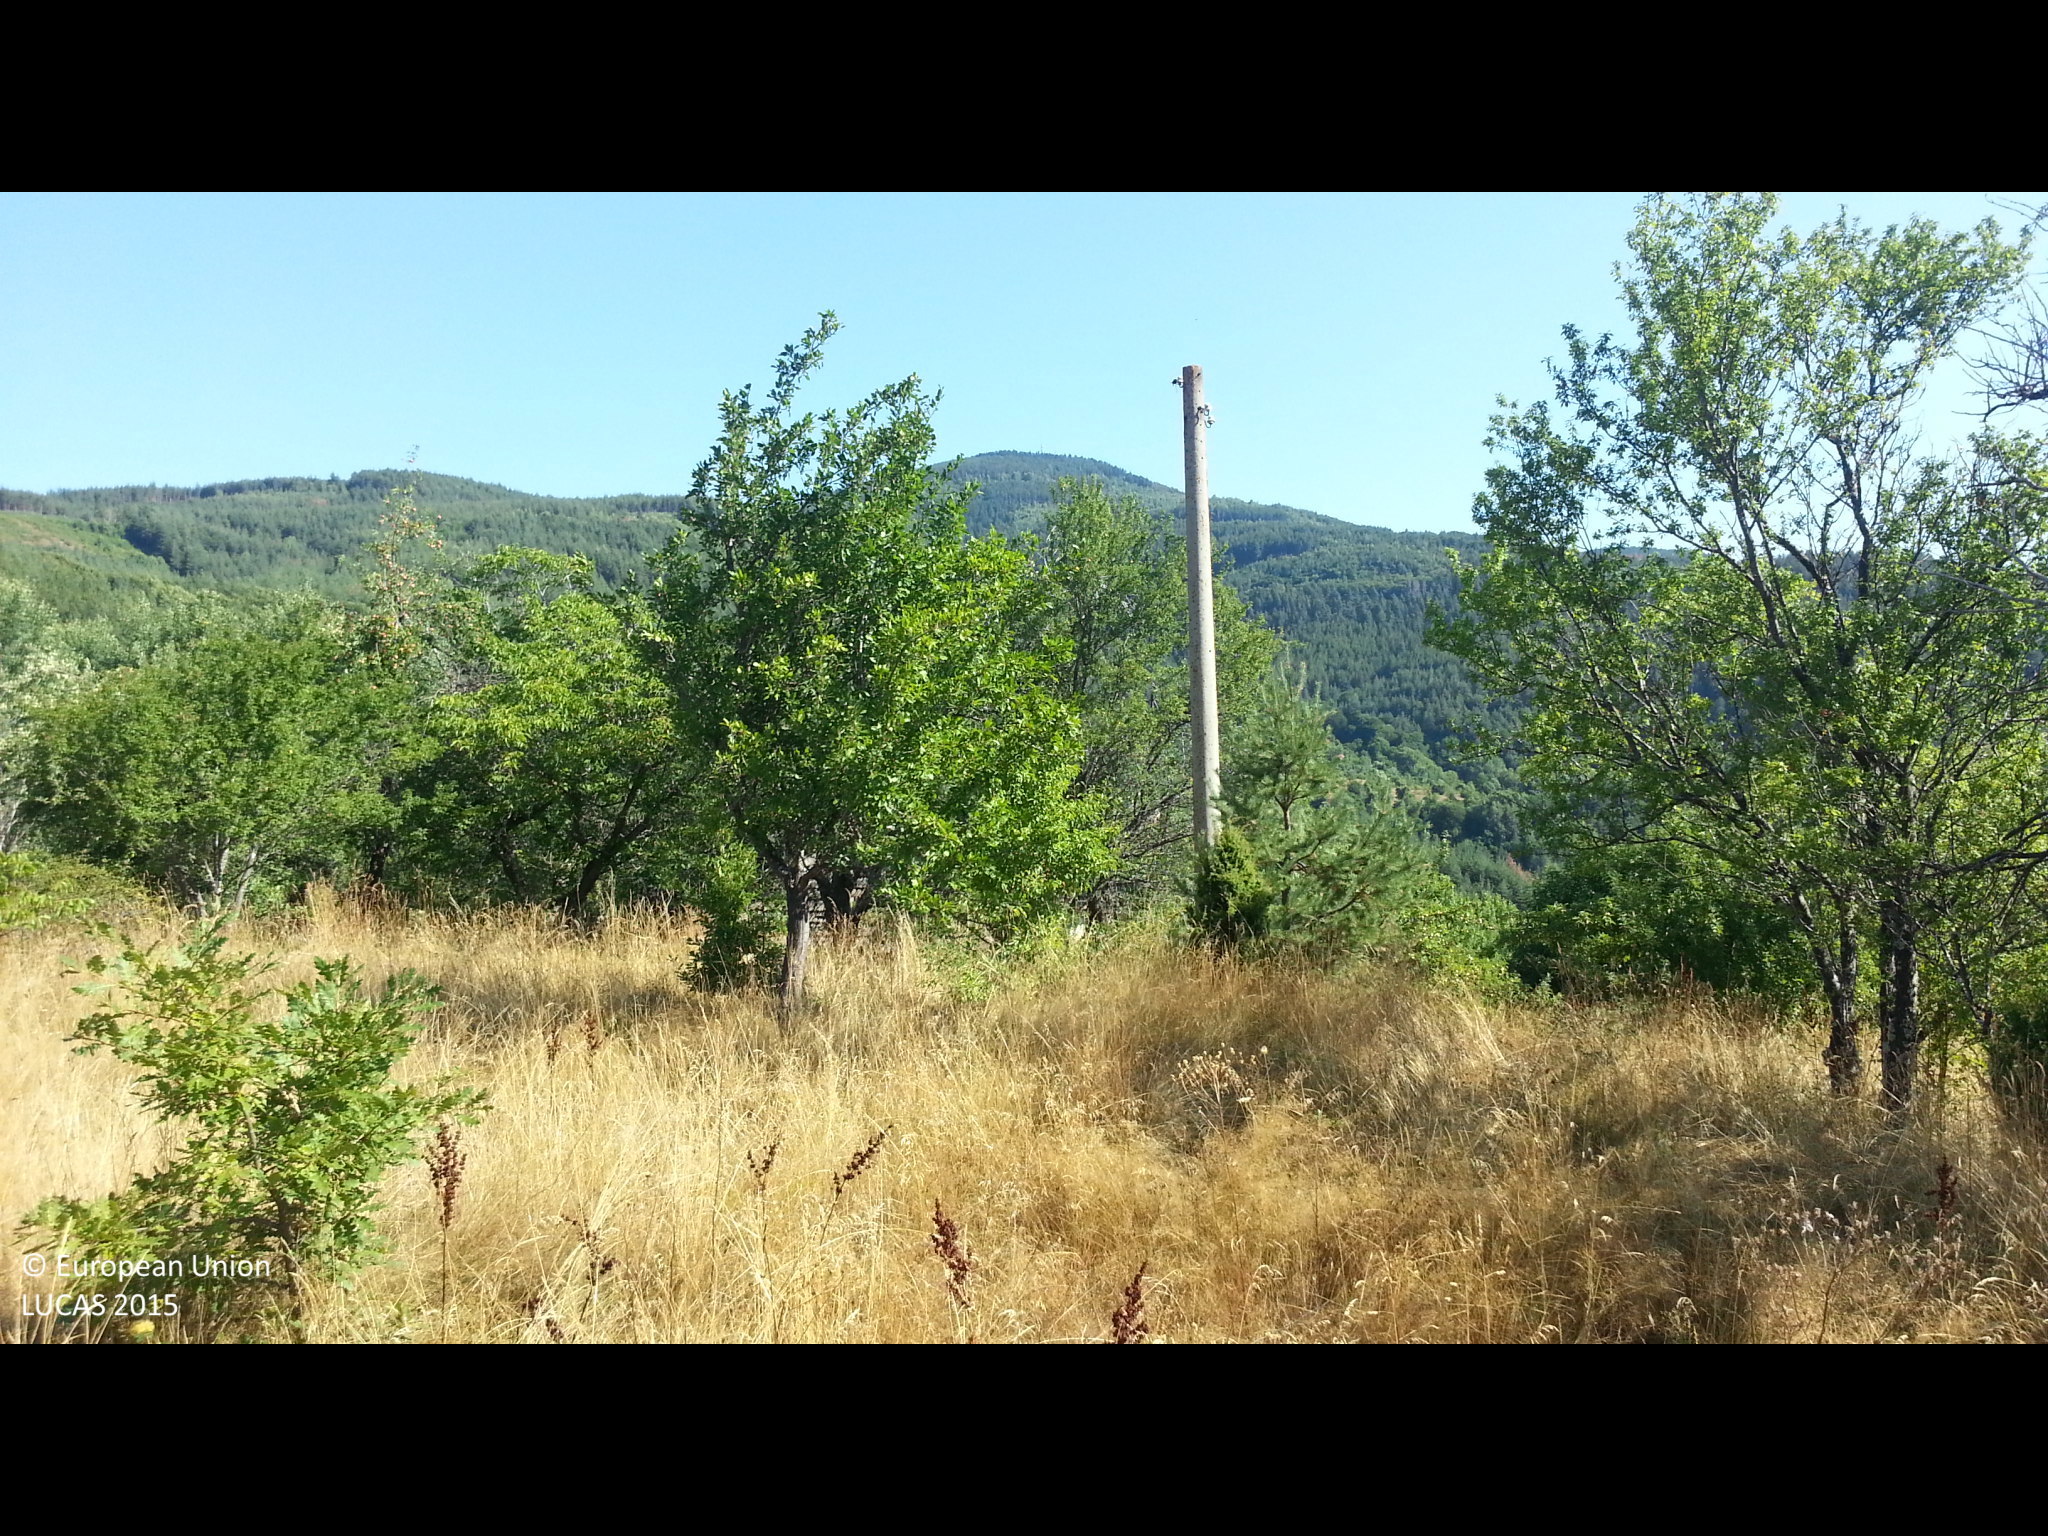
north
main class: Grassland
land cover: Grassland with sparse tree/shrub cover
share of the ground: > 75 %
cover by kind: herbaceous plants 90 %, broadleaved forest trees 5 %, shrubs 5 %
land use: Agriculture (excluding fallow land and kitchen gardens)
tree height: > 5 m
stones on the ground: < 10 %
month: August
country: BG
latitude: 42.2694
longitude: 22.5685
